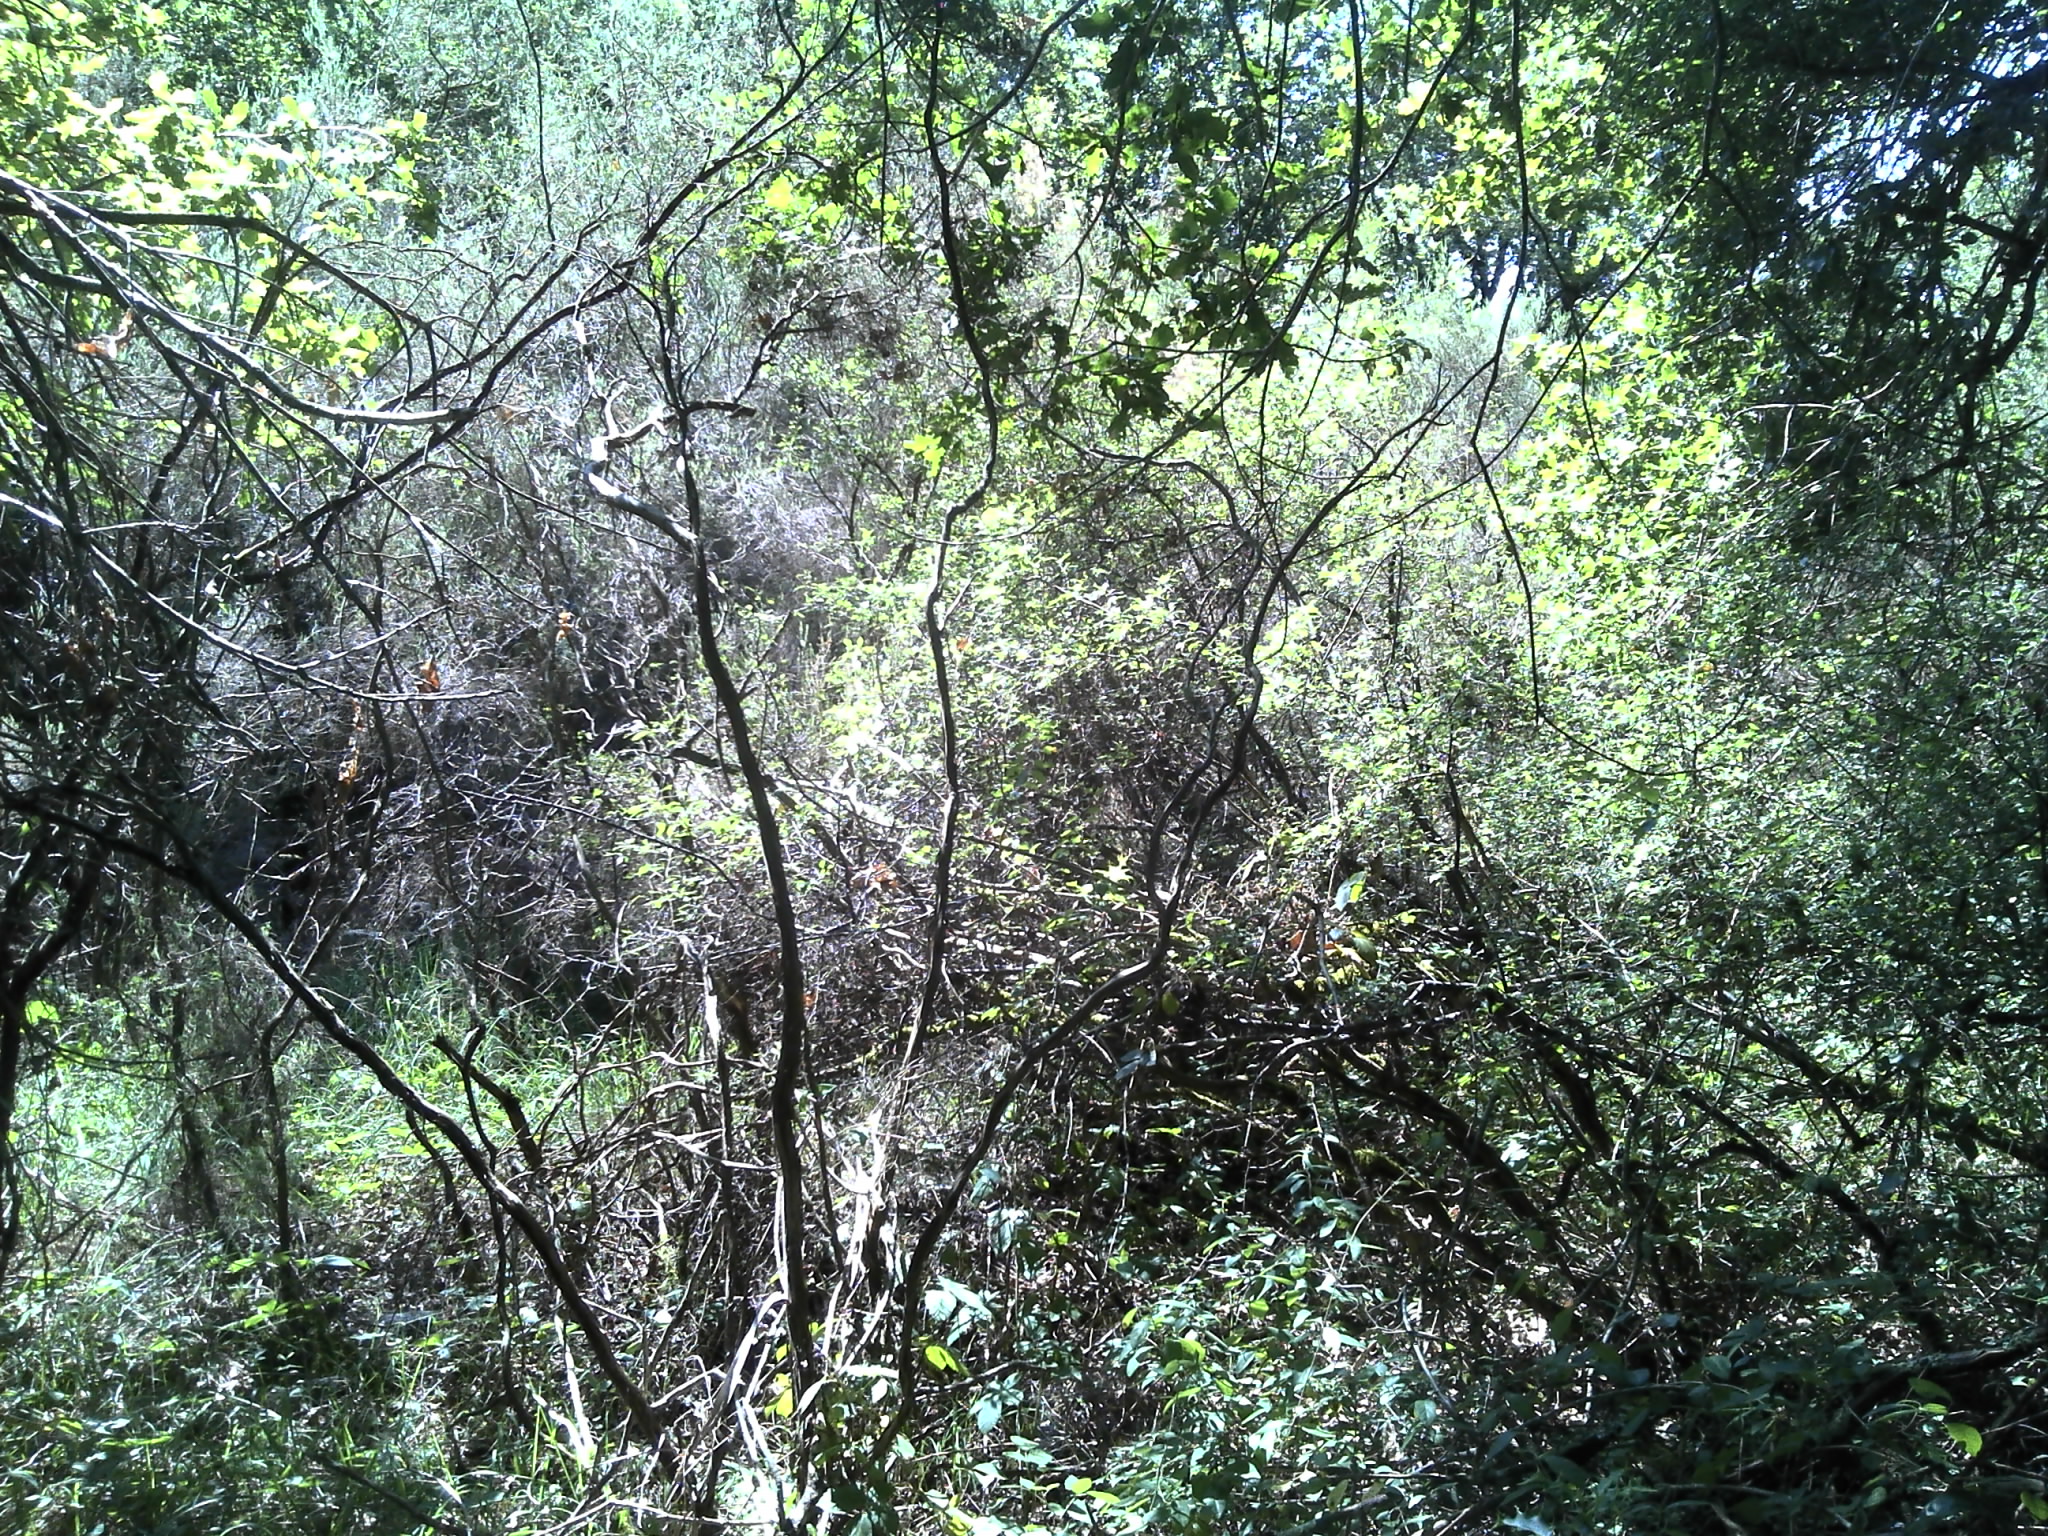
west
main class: Woodland
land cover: Broadleaved woodland
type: mesophytic deciduous forest
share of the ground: > 75 %
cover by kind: broadleaved forest trees 100 %
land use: Forestry
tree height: > 5 m
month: July
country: FR
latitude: 46.7446
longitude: 1.1514
